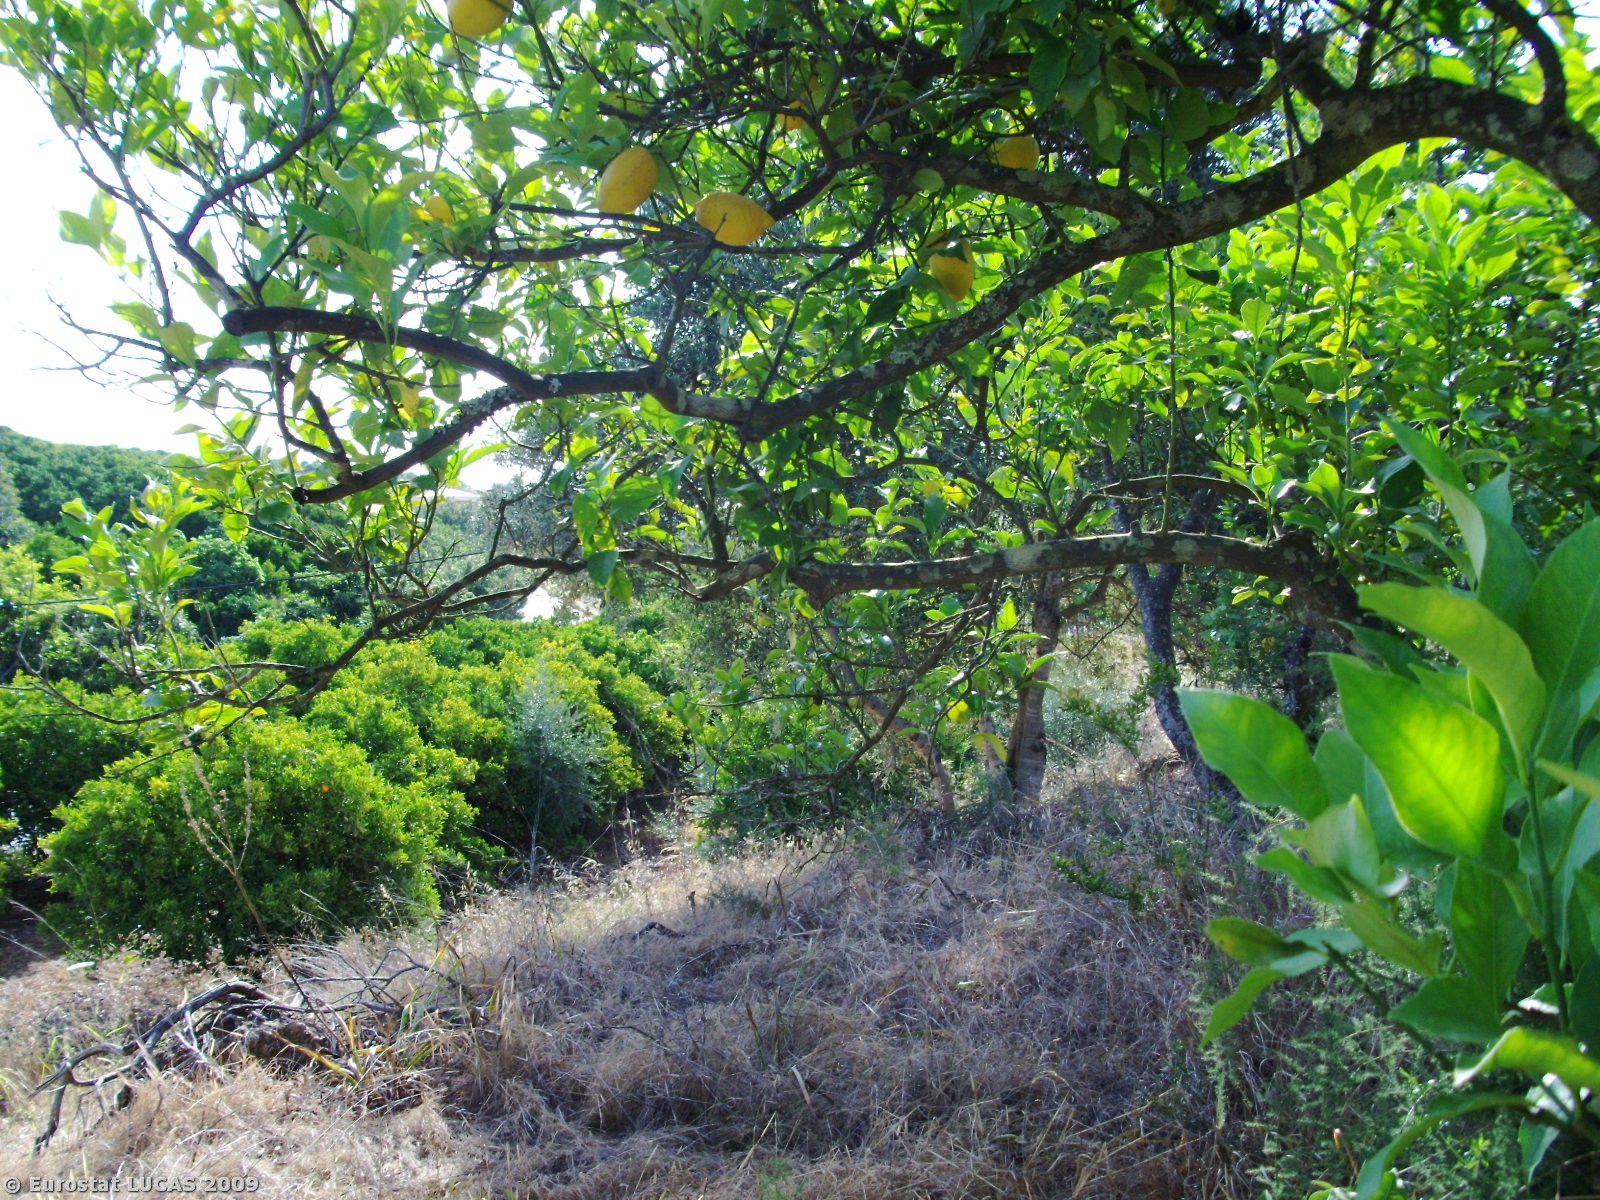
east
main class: Cropland
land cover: Other citrus fruit
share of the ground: 25 - 50 %
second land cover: Spontaneously vegetated surfaces
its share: 50 - 75 %
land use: Agriculture (excluding fallow land and kitchen gardens)
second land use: Fallow land
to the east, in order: Other citrus fruit; Spontaneously vegetated surfaces; Electric lines; Shruby margins; Tracks; Oranges; Grass margins; Oranges; Shrubland with sparse tree cover; Dry stone walls; Olive groves; Other structural elements; Spontaneously vegetated surfaces; Tracks; Permanent industrial crops; Dry stone walls; Oranges
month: May
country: PT
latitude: 37.1959
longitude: -8.3981
